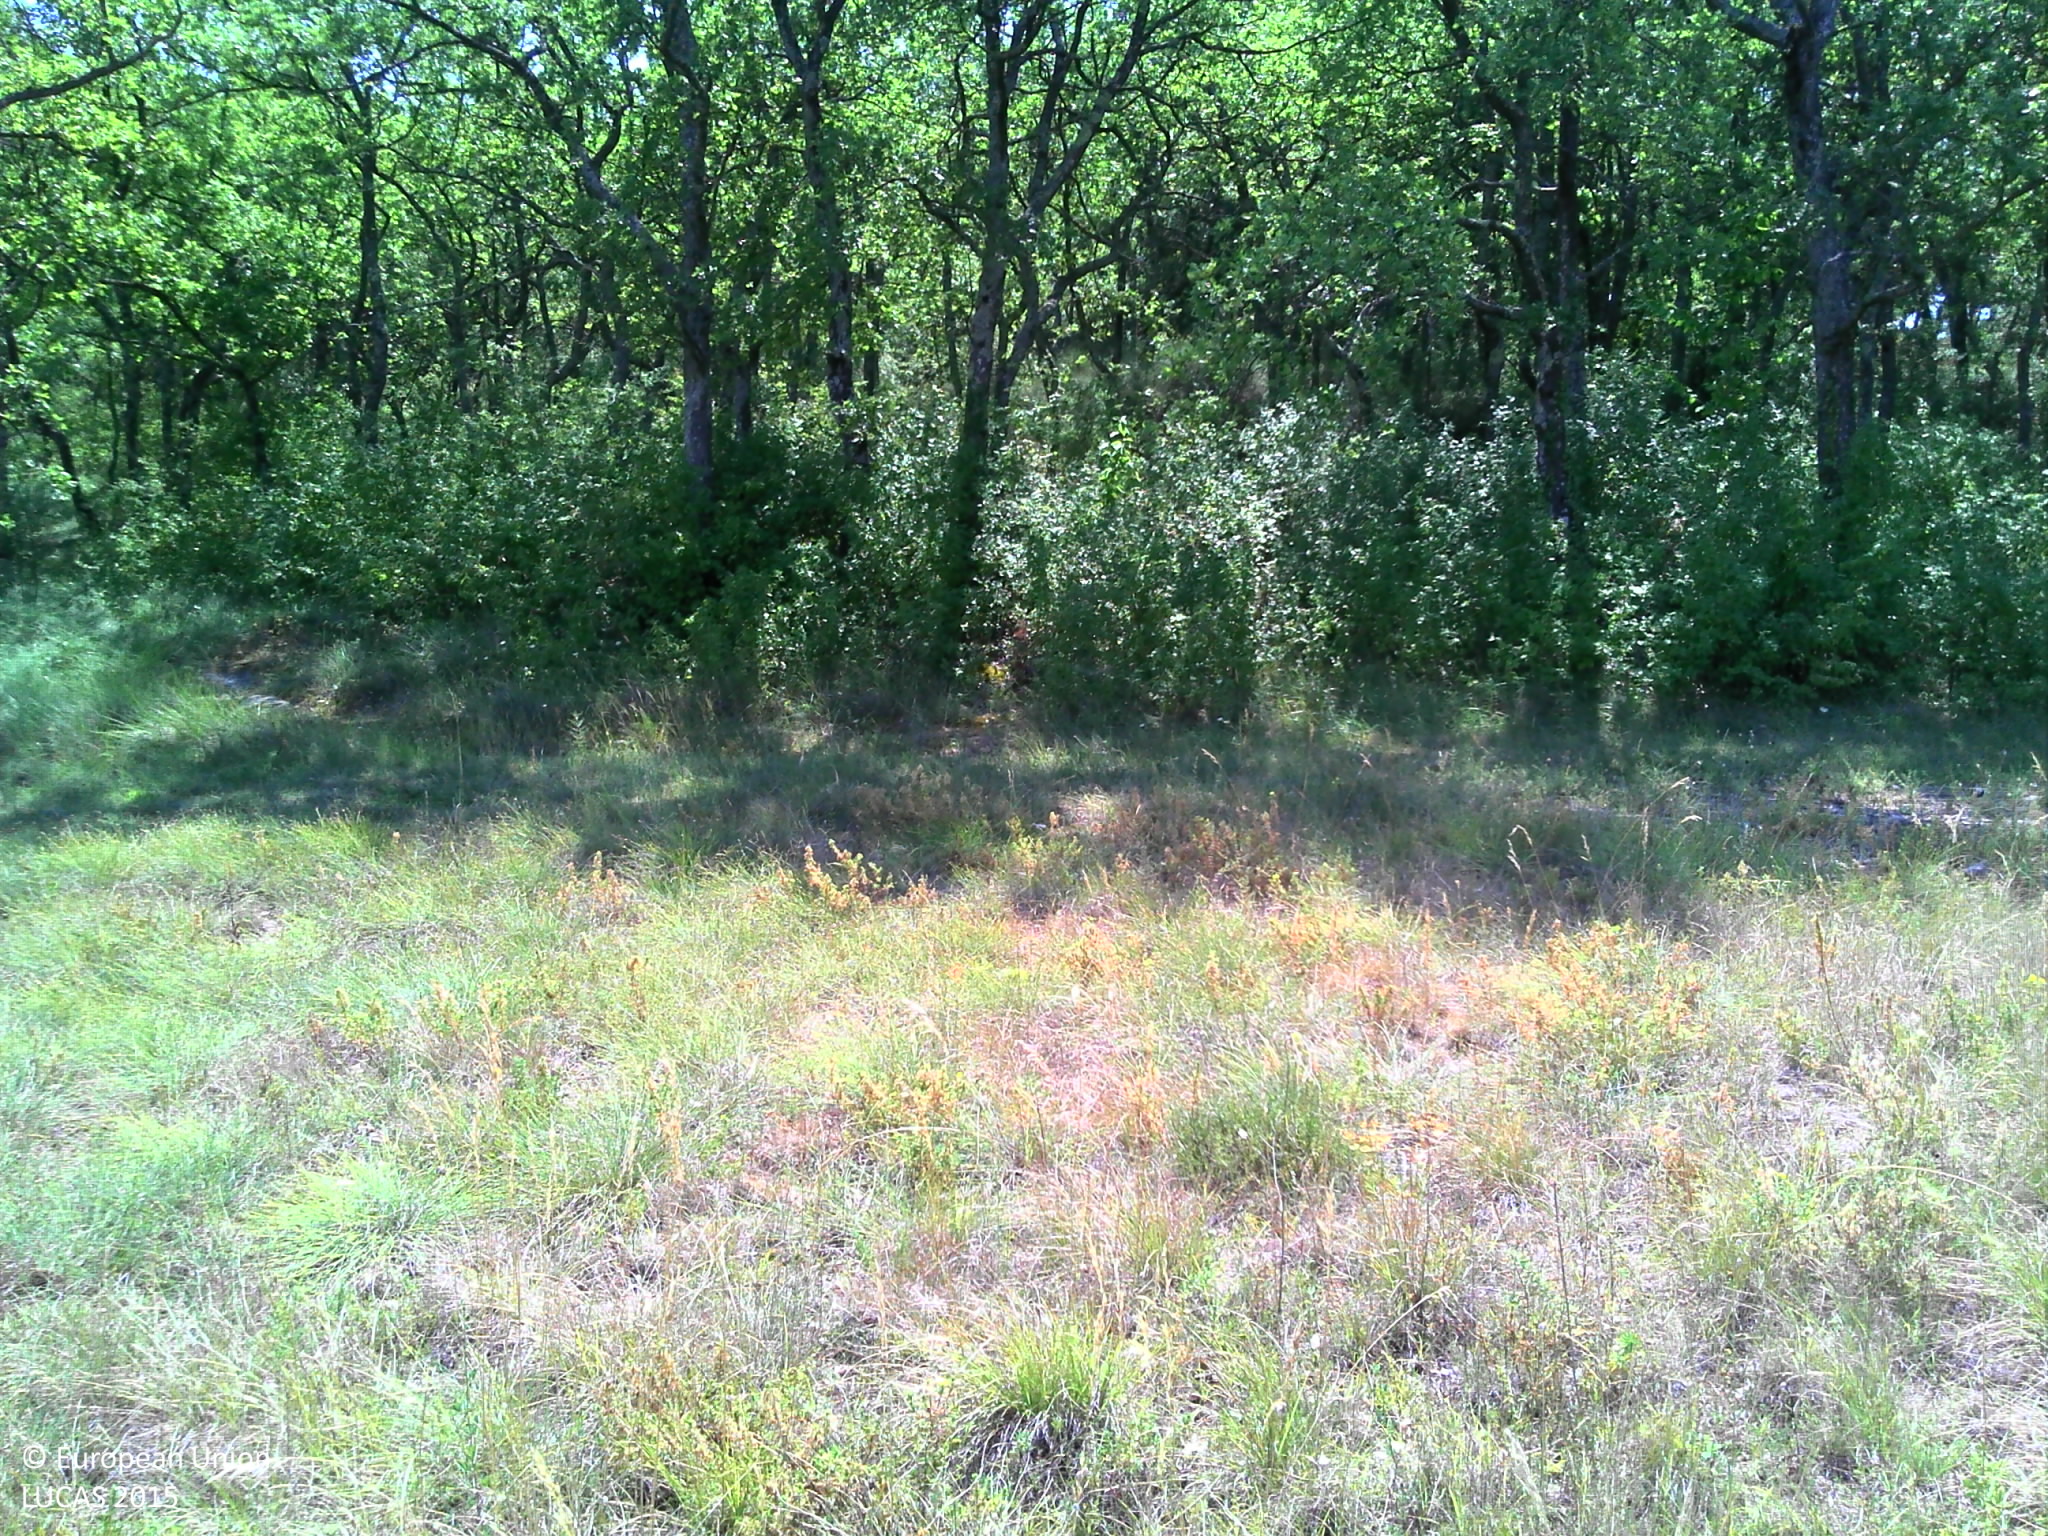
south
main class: Grassland
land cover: Spontaneously vegetated surfaces
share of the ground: > 75 %
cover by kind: herbaceous plants 95 %, lichens and mosses 5 %
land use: Semi-natural and natural areas not in use
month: August
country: FR
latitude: 43.8452
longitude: 5.2697
